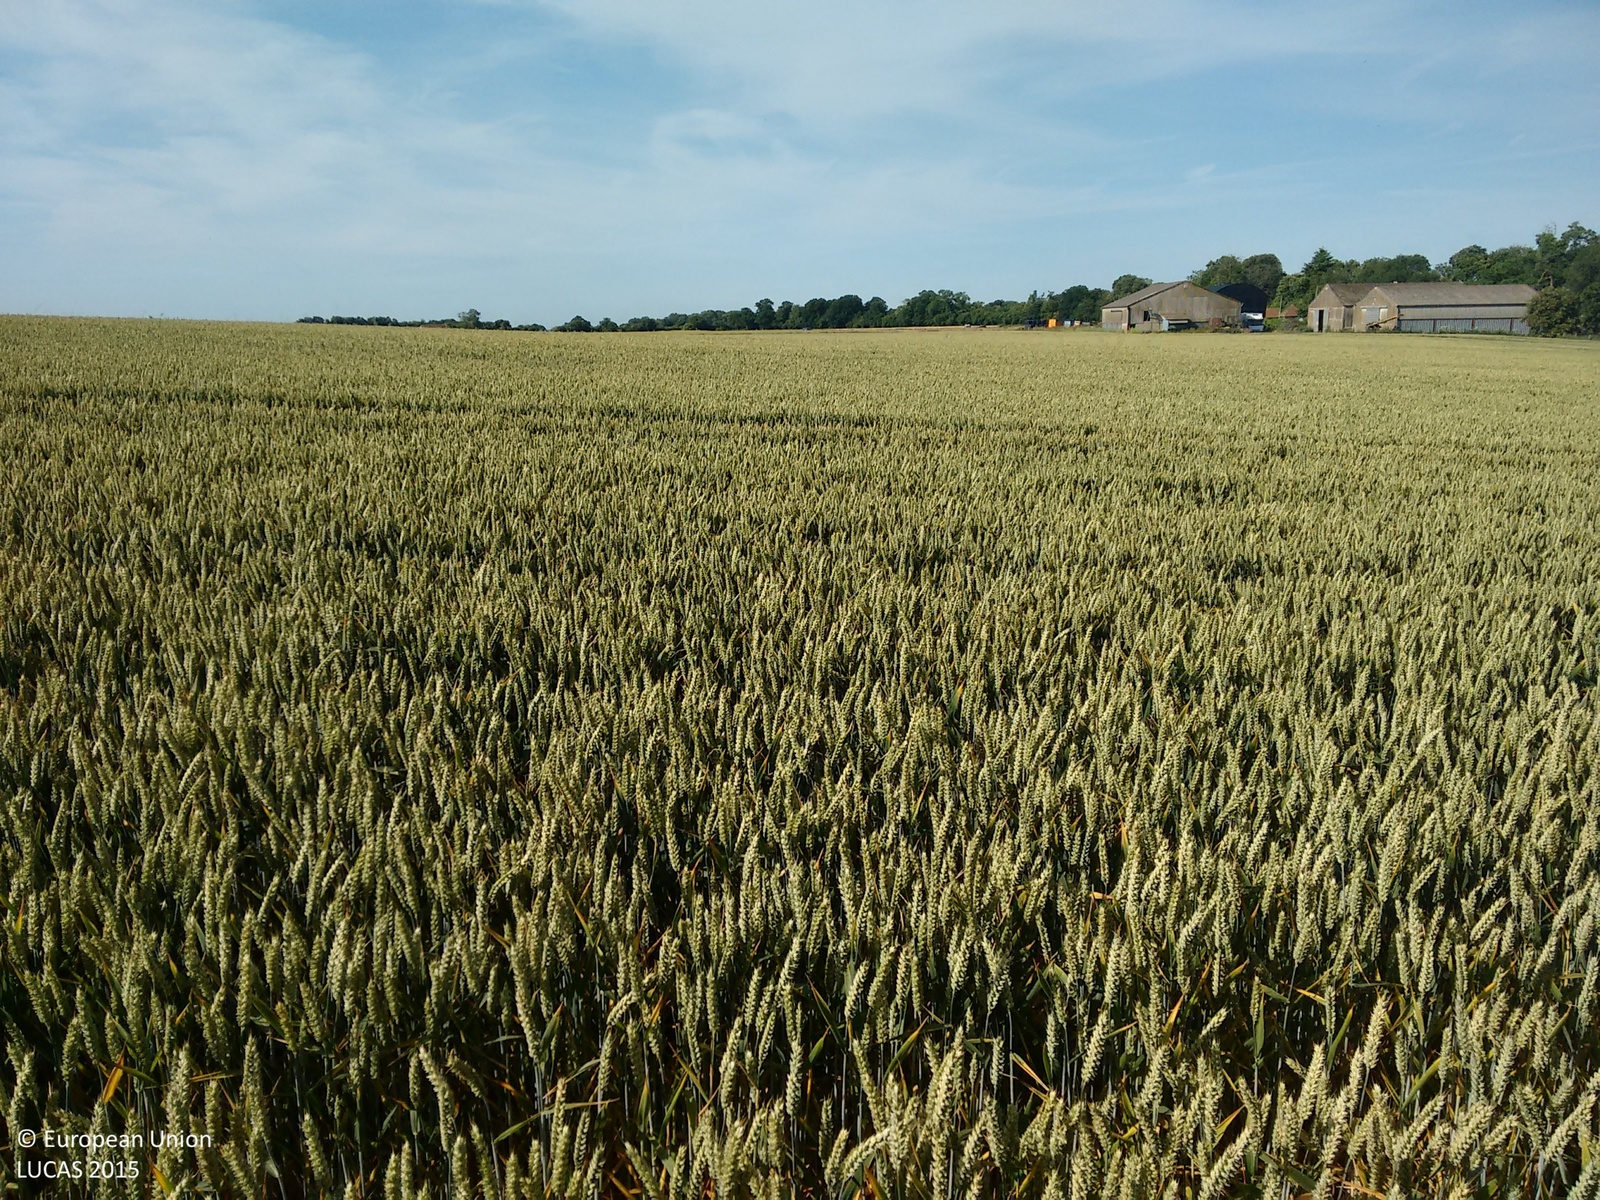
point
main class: Cropland
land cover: Common wheat
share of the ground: 50 - 75 %
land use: Agriculture (excluding fallow land and kitchen gardens)
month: July
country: GB
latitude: 50.8771
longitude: -0.8867
